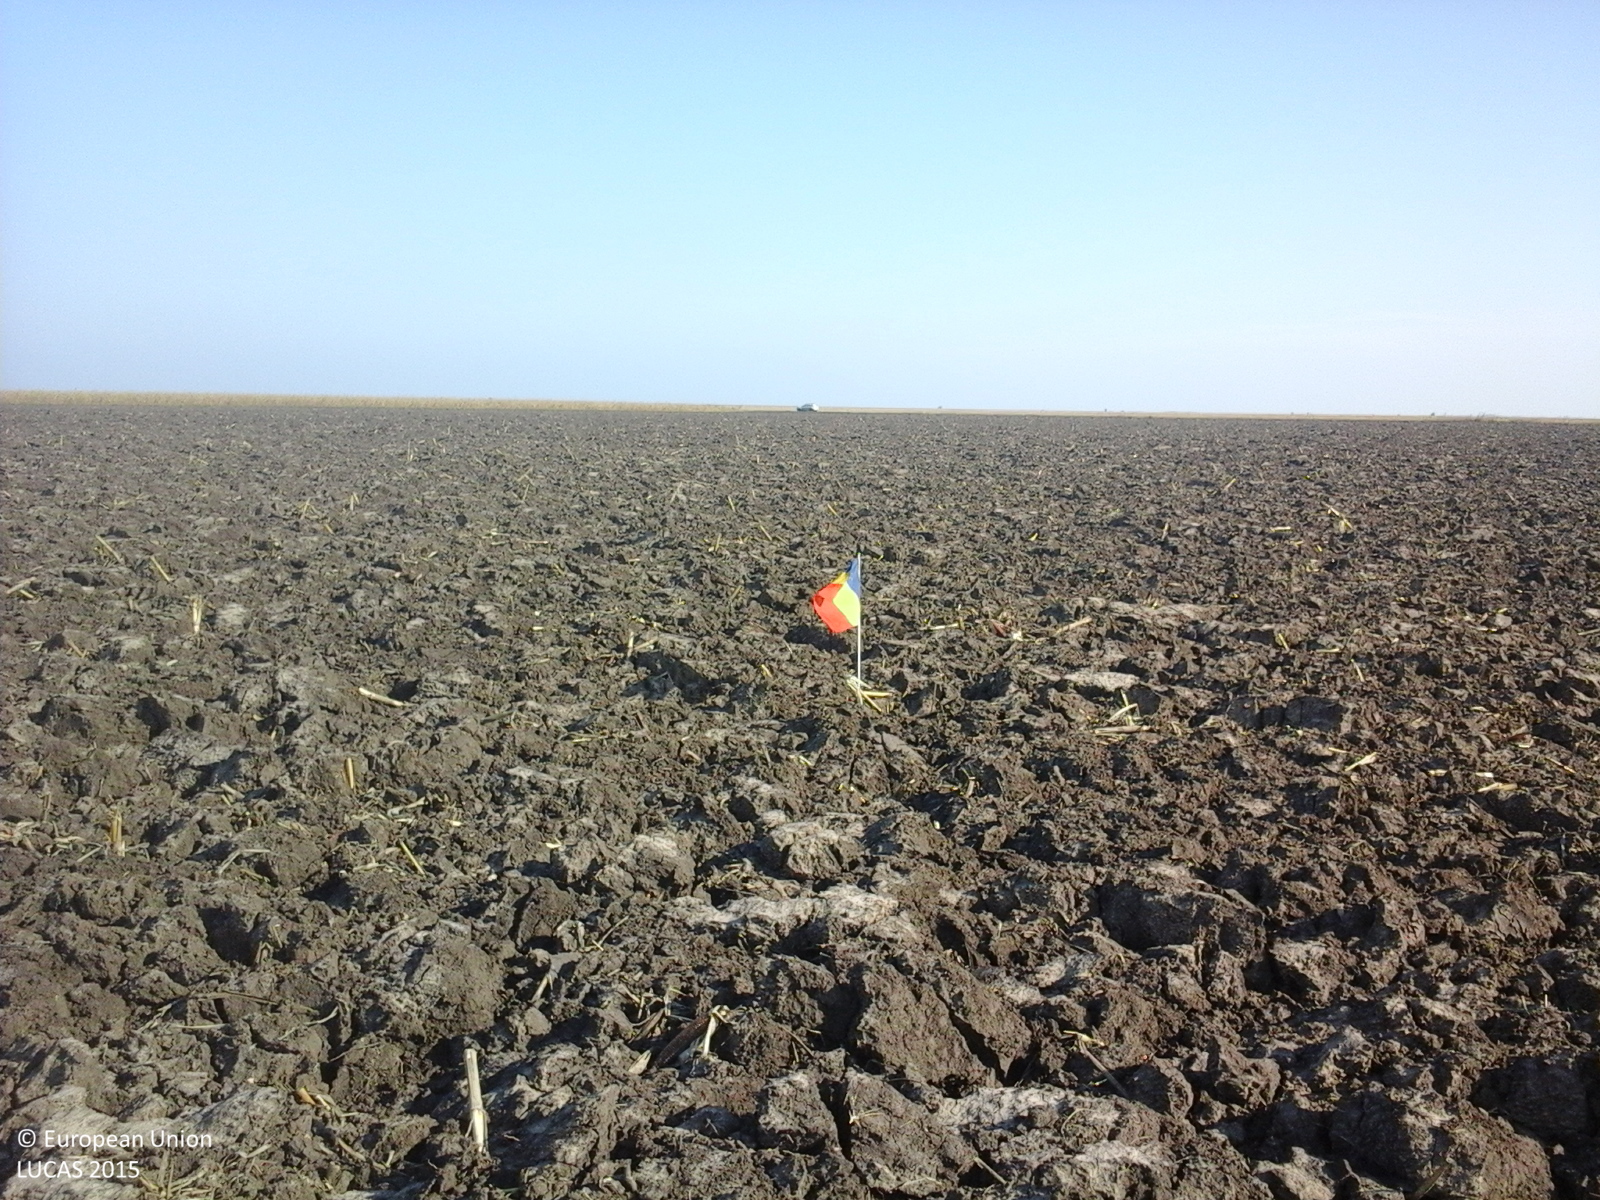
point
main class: Cropland
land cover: Maize
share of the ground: < 10 %
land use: Agriculture (excluding fallow land and kitchen gardens)
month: October
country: RO
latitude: 45.1627
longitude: 26.9921
